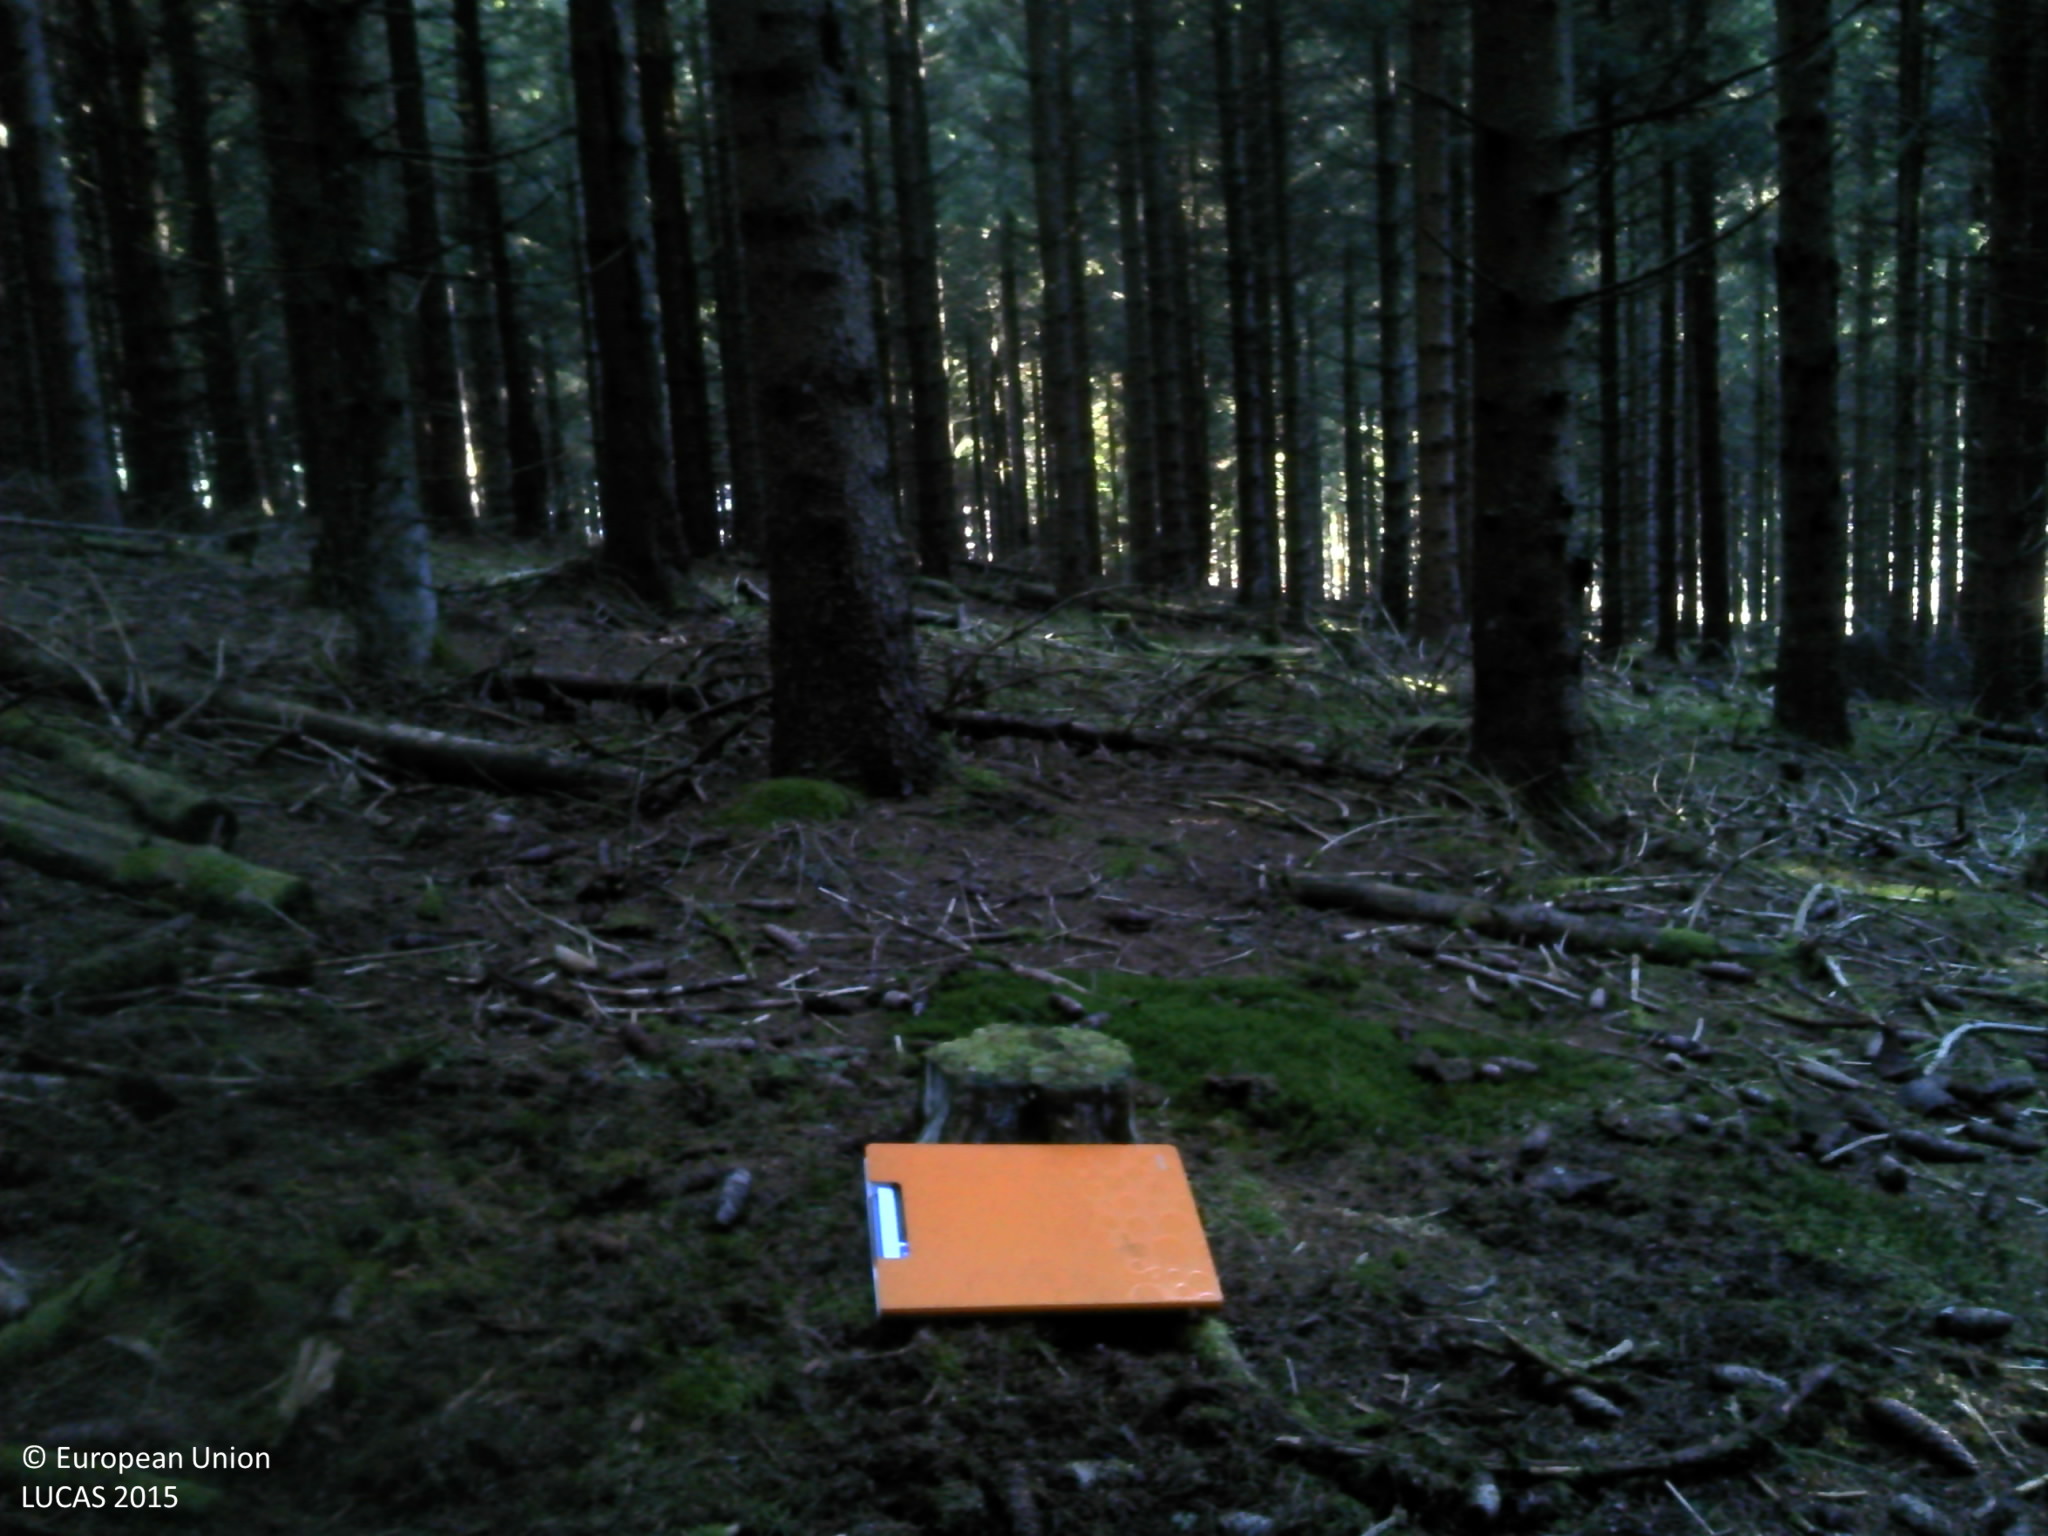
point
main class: Woodland
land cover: Spruce dominated coniferous woodland
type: exotic forest
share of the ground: > 75 %
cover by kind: coniferous forest trees 90 %, lichens and mosses 5 %, unconsolidated bare surface 5 %
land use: Forestry
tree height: > 5 m
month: October
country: FR
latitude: 45.4822
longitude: 2.8996
